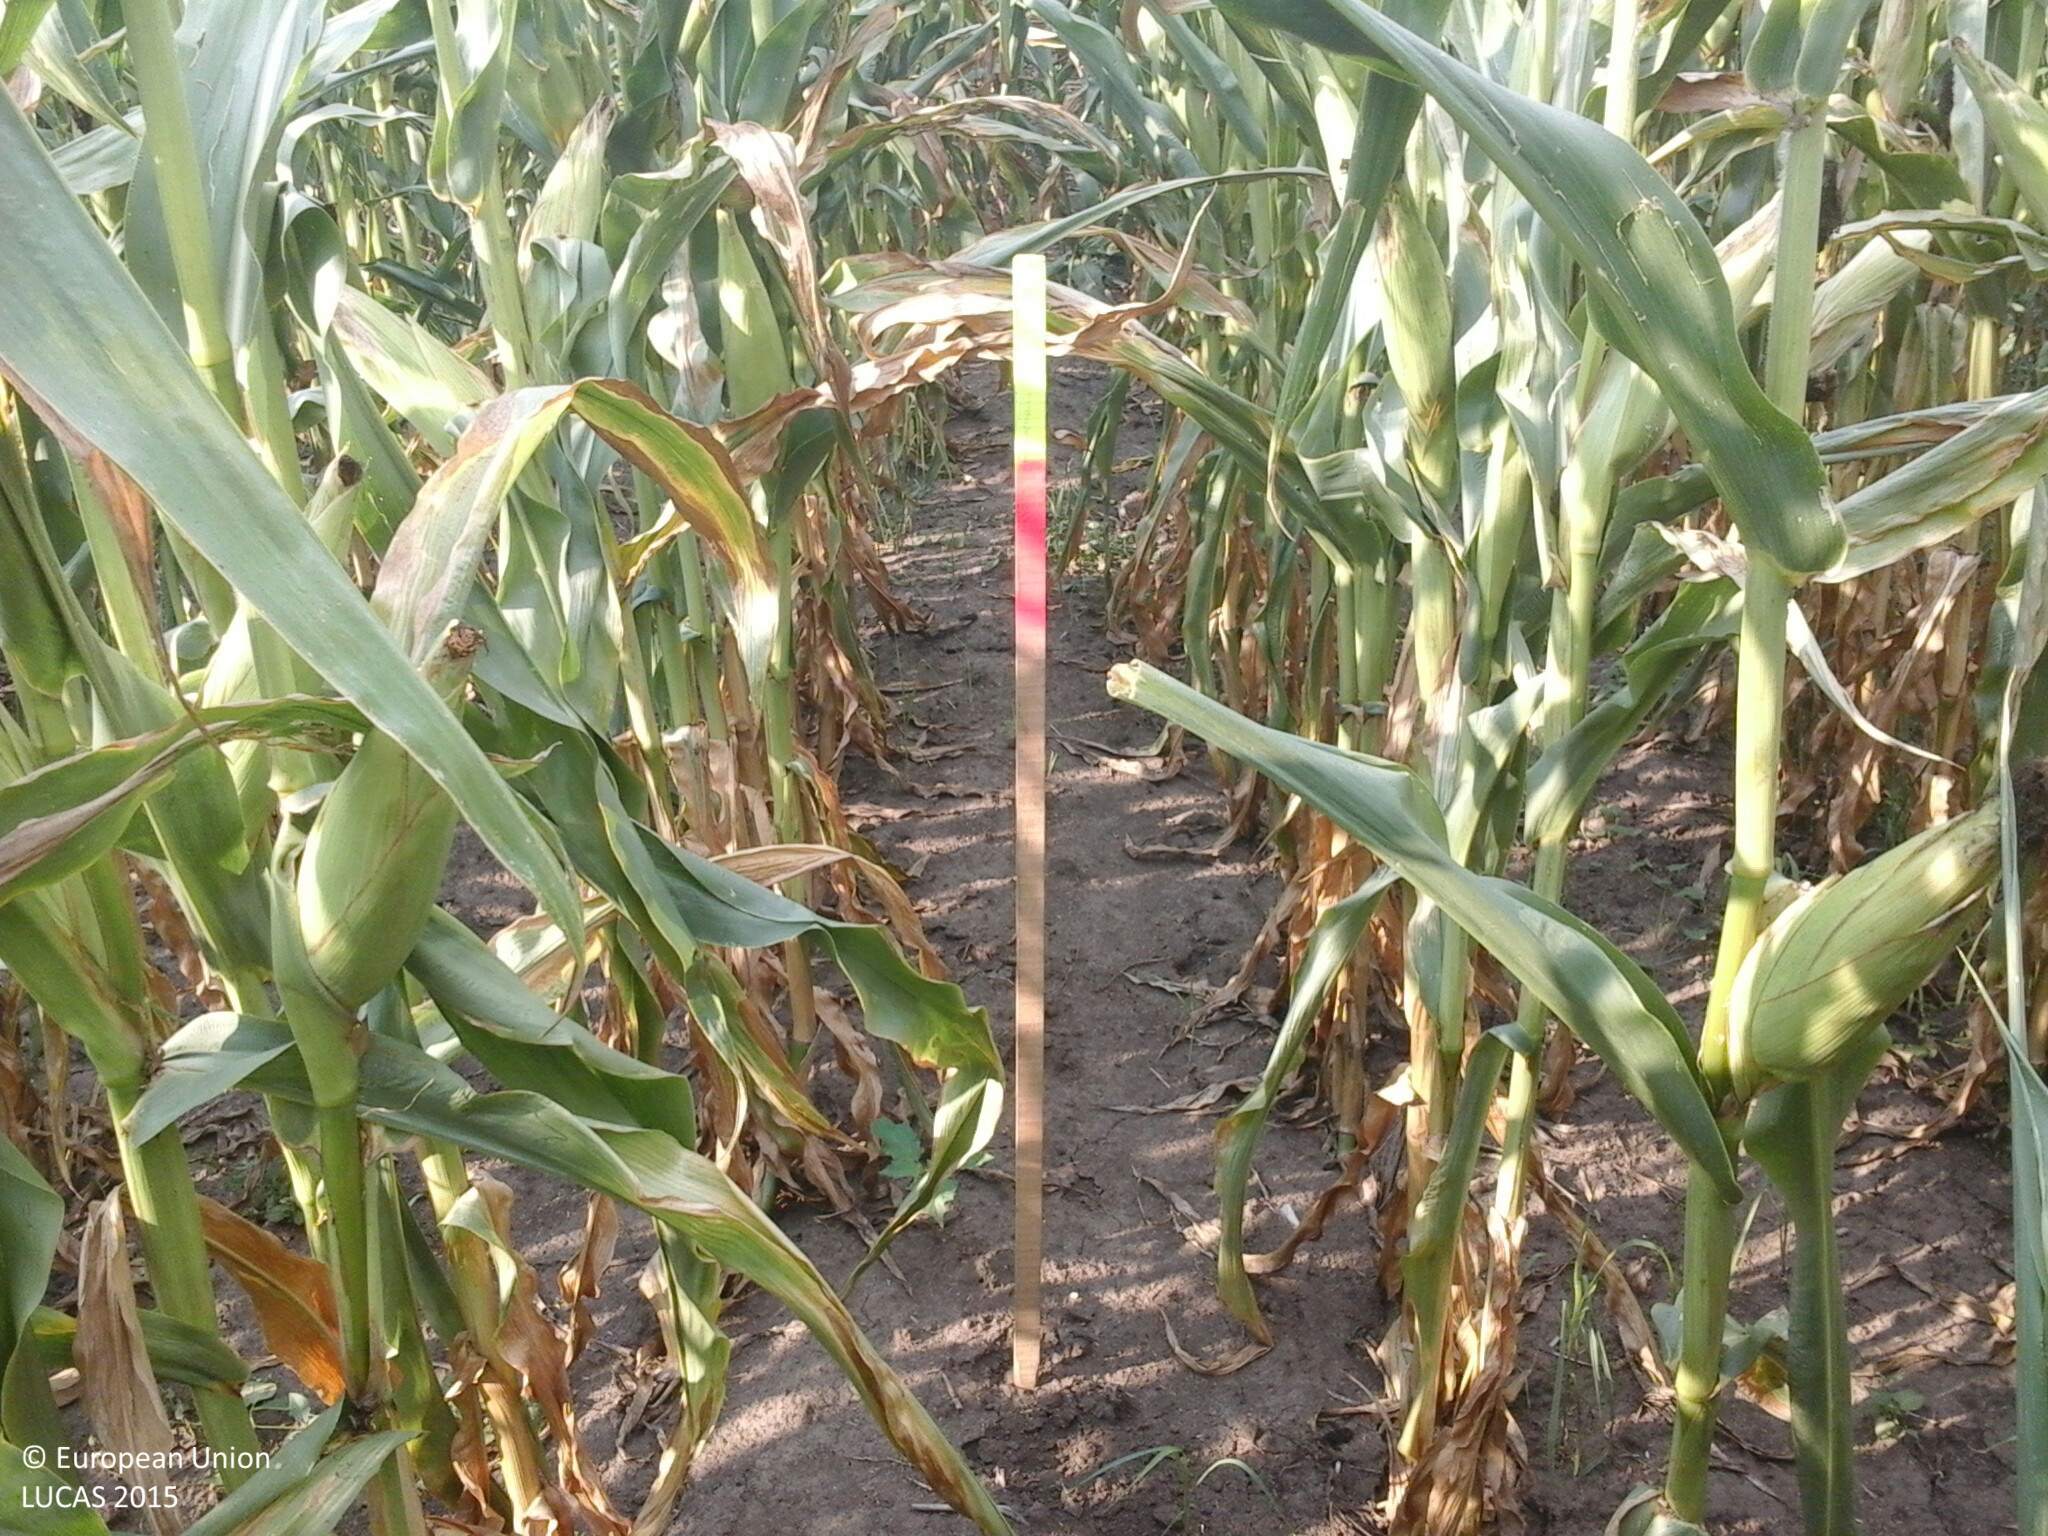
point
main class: Cropland
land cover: Maize
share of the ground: > 75 %
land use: Agriculture (excluding fallow land and kitchen gardens)
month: August
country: HU
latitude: 46.8517
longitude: 18.4178
